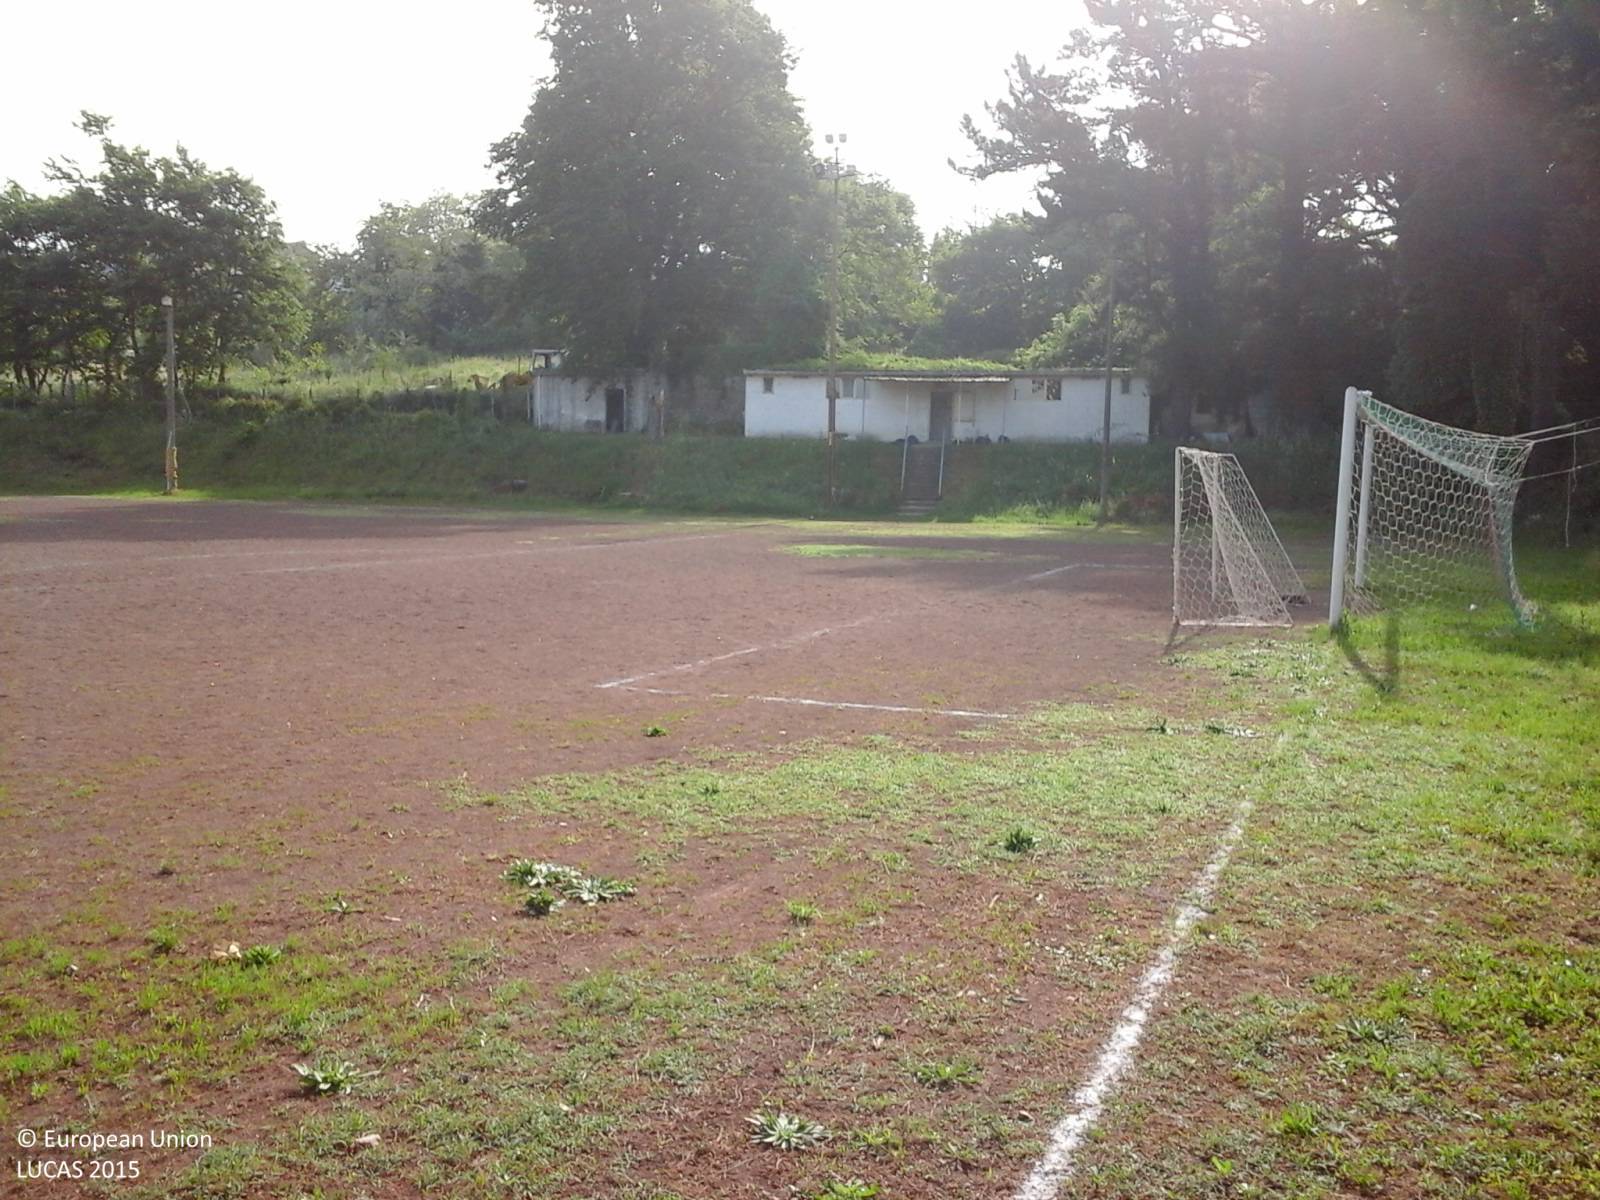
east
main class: Grassland
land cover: Grassland without tree/shrub cover
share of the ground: > 75 %
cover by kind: herbaceous plants 100 %
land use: Sport
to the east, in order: Grassland without tree/shrub cover; Artificial constructions in urban areas
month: May
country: IT
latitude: 42.5249
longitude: 12.0504
